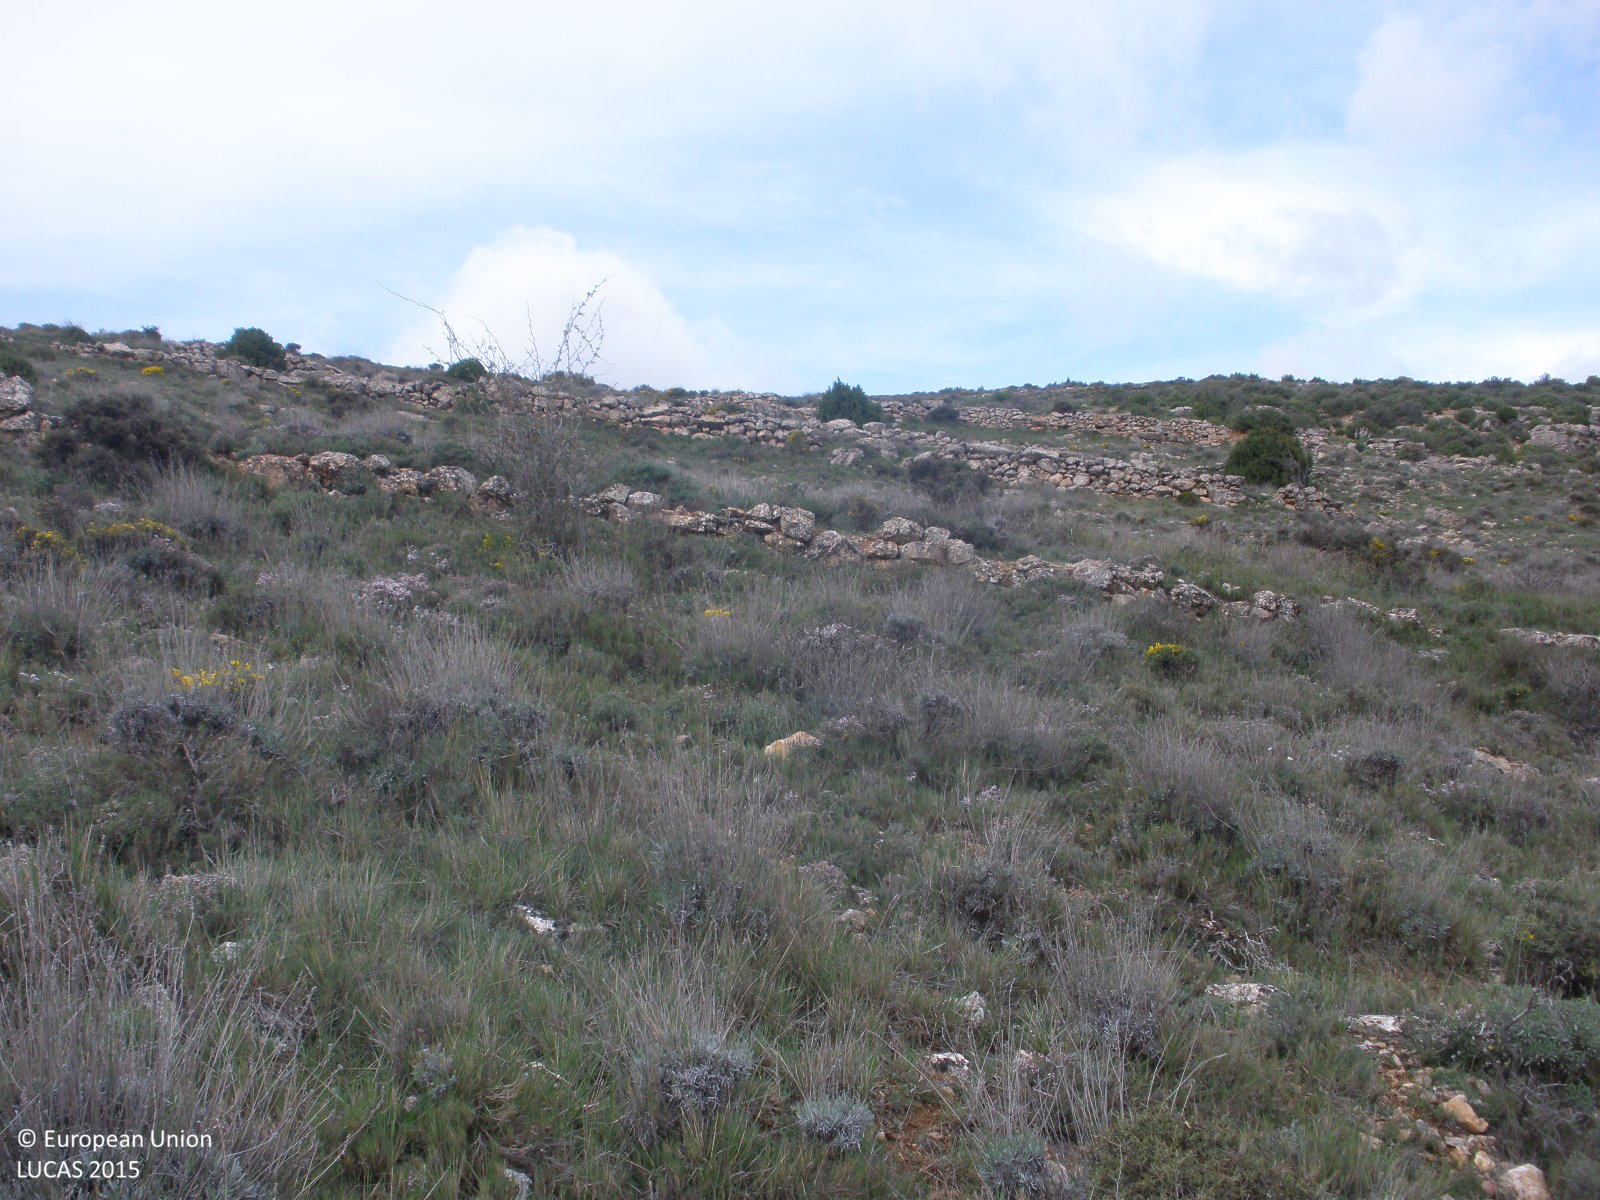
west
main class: Shrubland
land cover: Shrubland without tree cover
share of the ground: 50 - 75 %
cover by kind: shrubs 60 %, herbaceous plants 30 %, consolidated bare surface 10 %
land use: Semi-natural and natural areas not in use
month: May
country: ES
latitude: 40.9391
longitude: -0.8591
